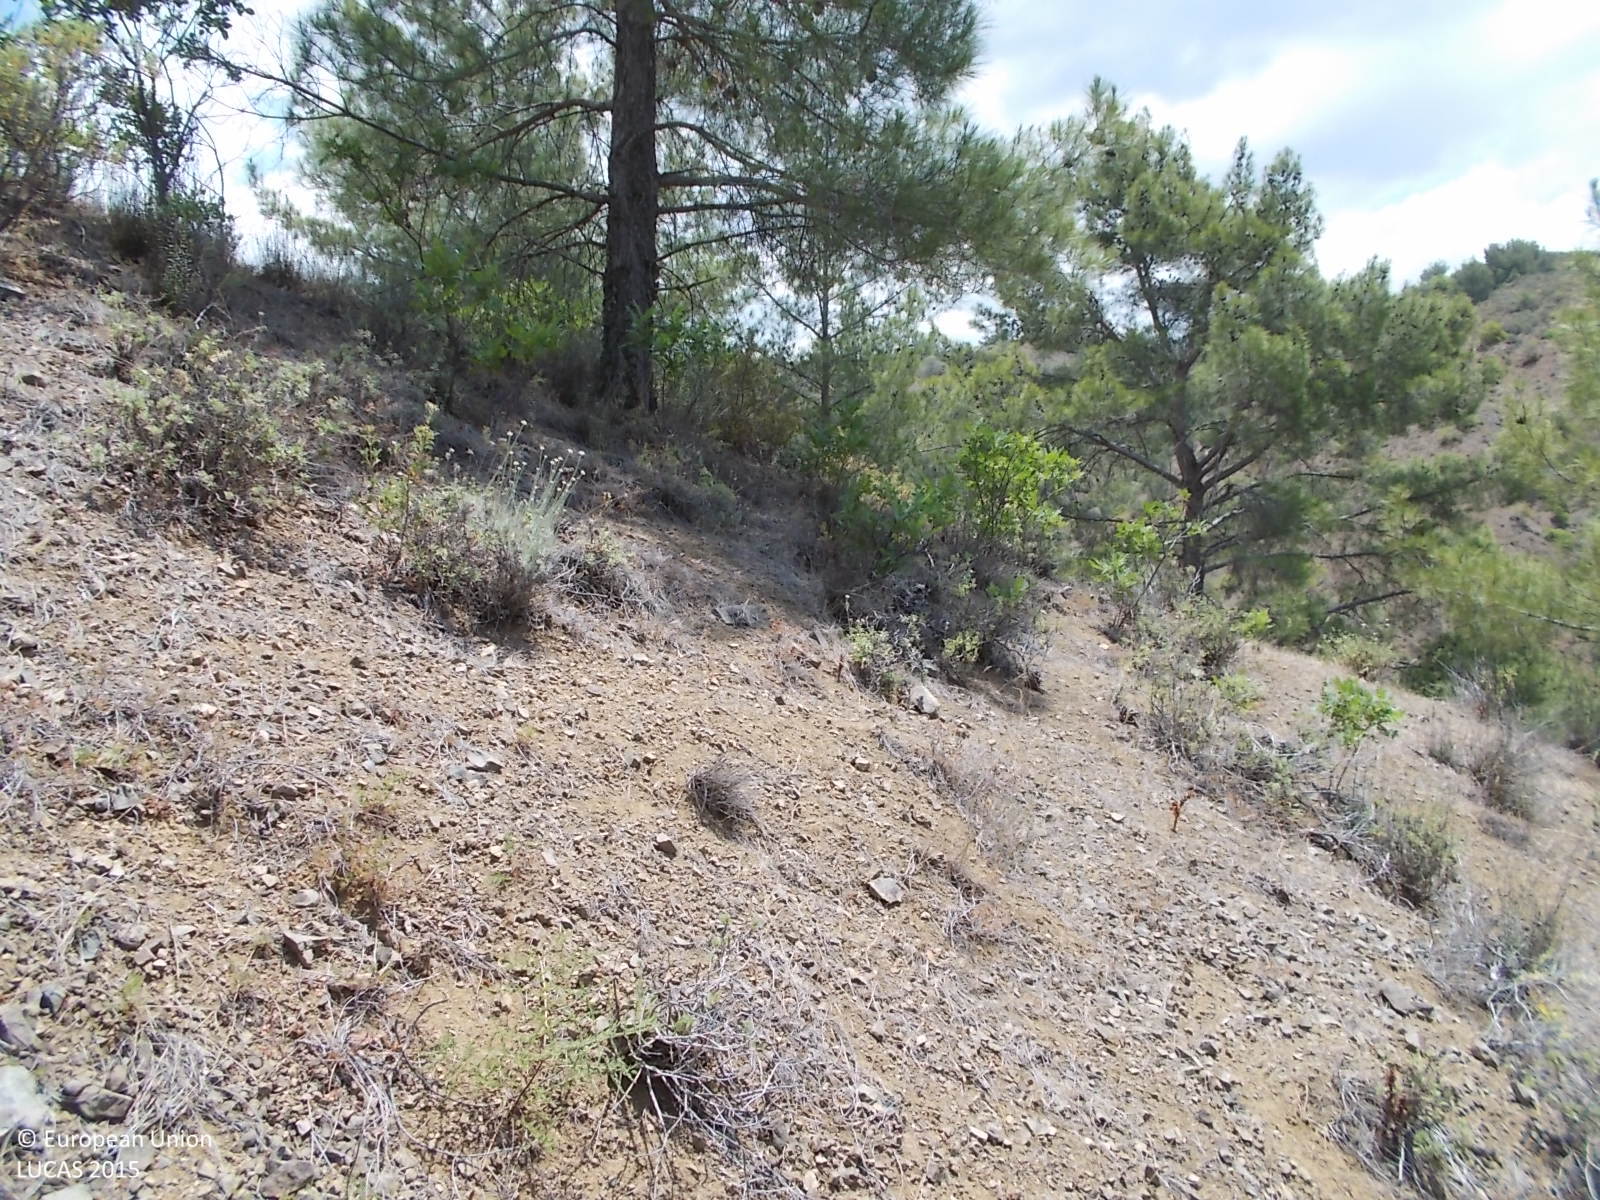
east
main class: Woodland
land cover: Pine dominated coniferous woodland
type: coniferous forest of the mediterranean region
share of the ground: 25 - 50 %
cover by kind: coniferous forest trees 40 %, unconsolidated bare surface 40 %, shrubs 20 %
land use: Forestry
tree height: > 5 m
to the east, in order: Pine dominated coniferous woodland; Fences; Pine dominated coniferous woodland; Tracks; Nuts trees; Fences; Electric lines; Tracks; Broadleaved woodland; Rivers and streams; Broadleaved woodland; Grassland without tree/shrub cover; Pine dominated coniferous woodland; Shrubland with sparse tree cover; Shrubland without tree cover; Pine dominated coniferous woodland
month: June
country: CY
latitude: 34.8772
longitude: 32.8205
